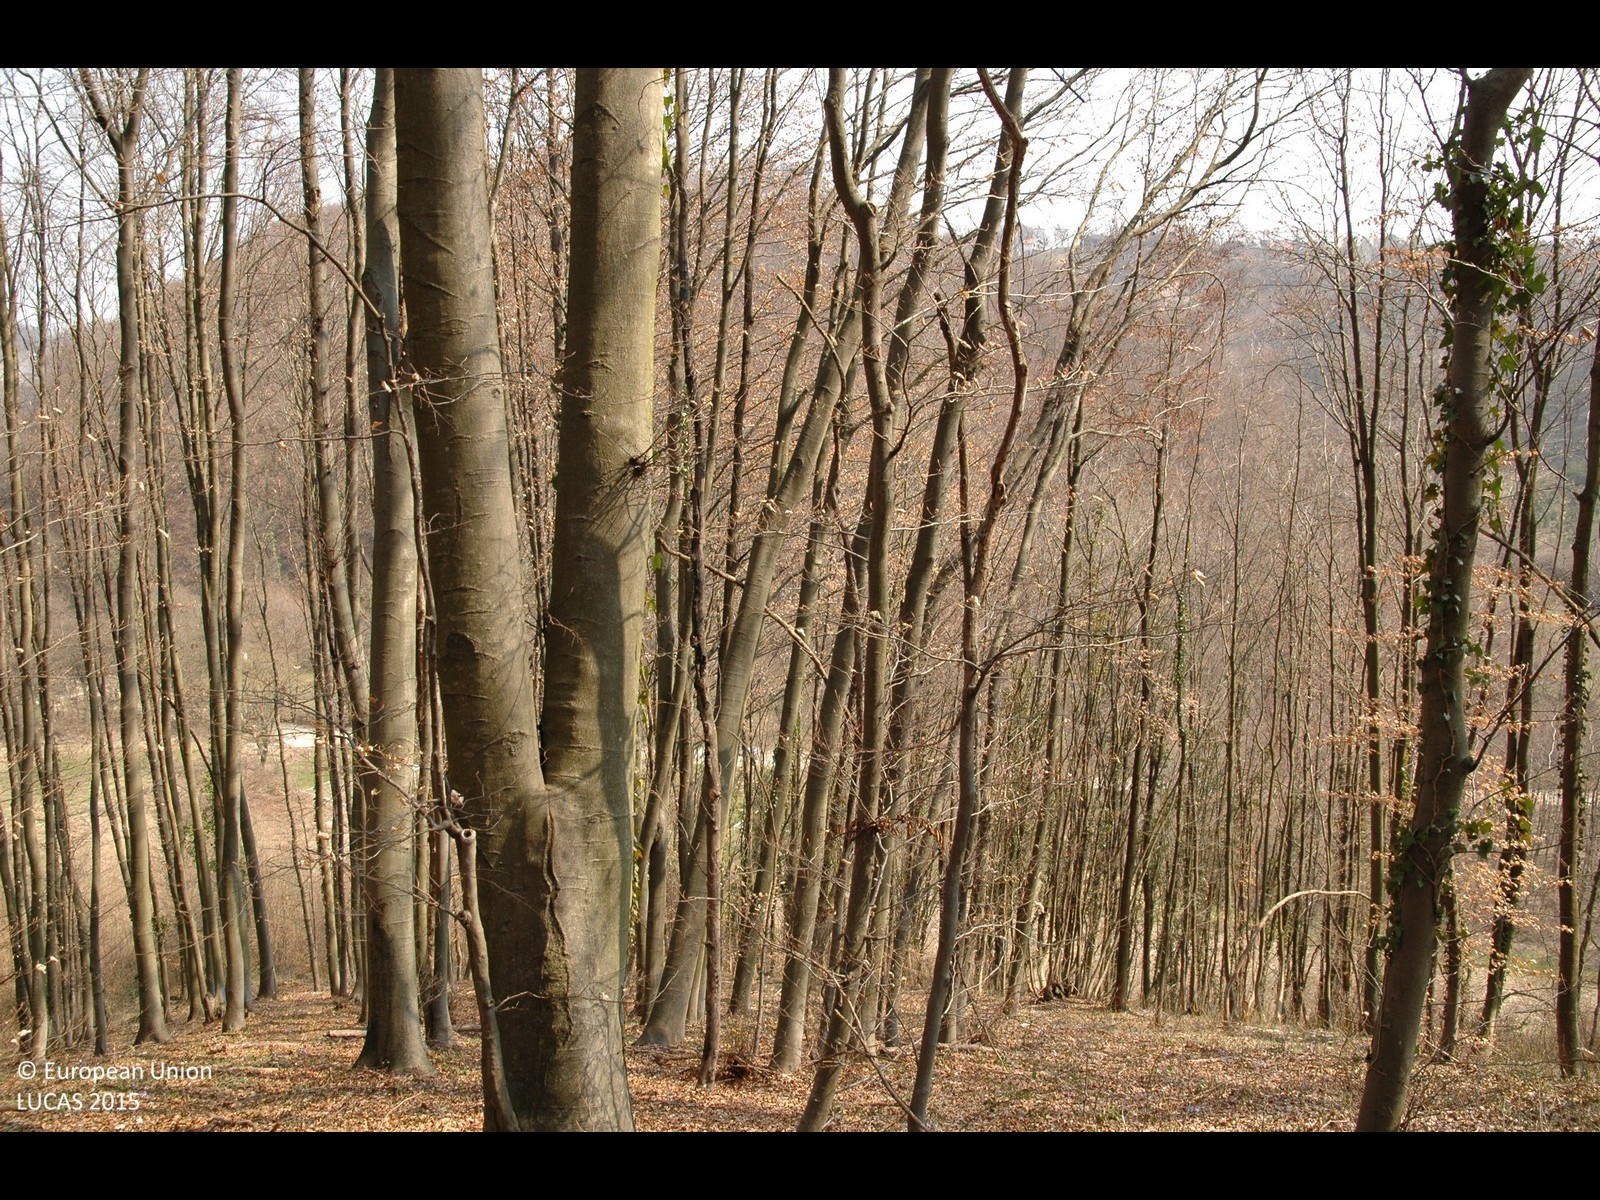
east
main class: Woodland
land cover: Broadleaved woodland
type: beech forest
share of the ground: > 75 %
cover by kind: broadleaved forest trees 95 %
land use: Forestry
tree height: > 5 m
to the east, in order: Broadleaved woodland; Grassland without tree/shrub cover; Paved roads, cycling and walking lanes; Grass margins; Rivers and streams; Broadleaved woodland
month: March
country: HR
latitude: 46.1979
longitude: 16.3626
